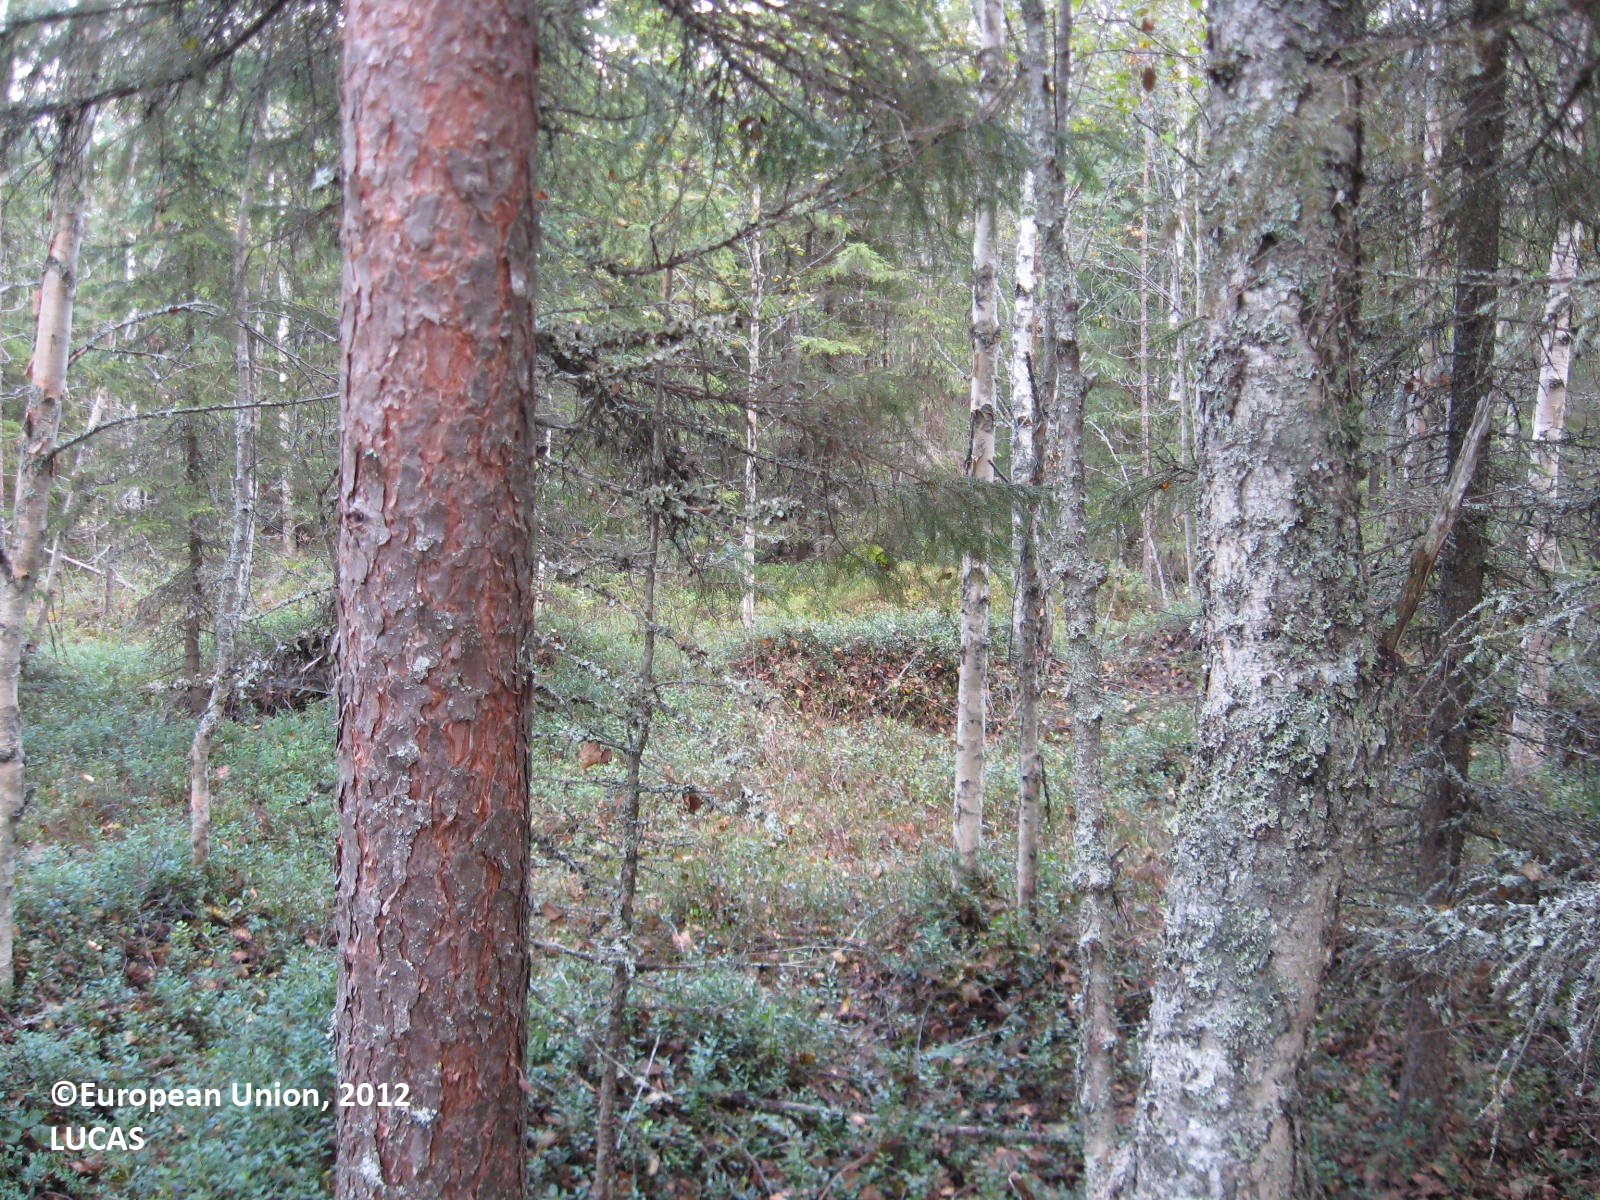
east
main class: Woodland
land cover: Pine dominated mixed woodland
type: boreal forest
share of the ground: > 75 %
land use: Forestry
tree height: > 5 m
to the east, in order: Pine dominated mixed woodland; Ditches and canals; Pine dominated mixed woodland; Ditches and canals; Pine dominated mixed woodland; Spruce dominated mixed woodland
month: August
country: FI
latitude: 63.6434
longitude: 29.2958
